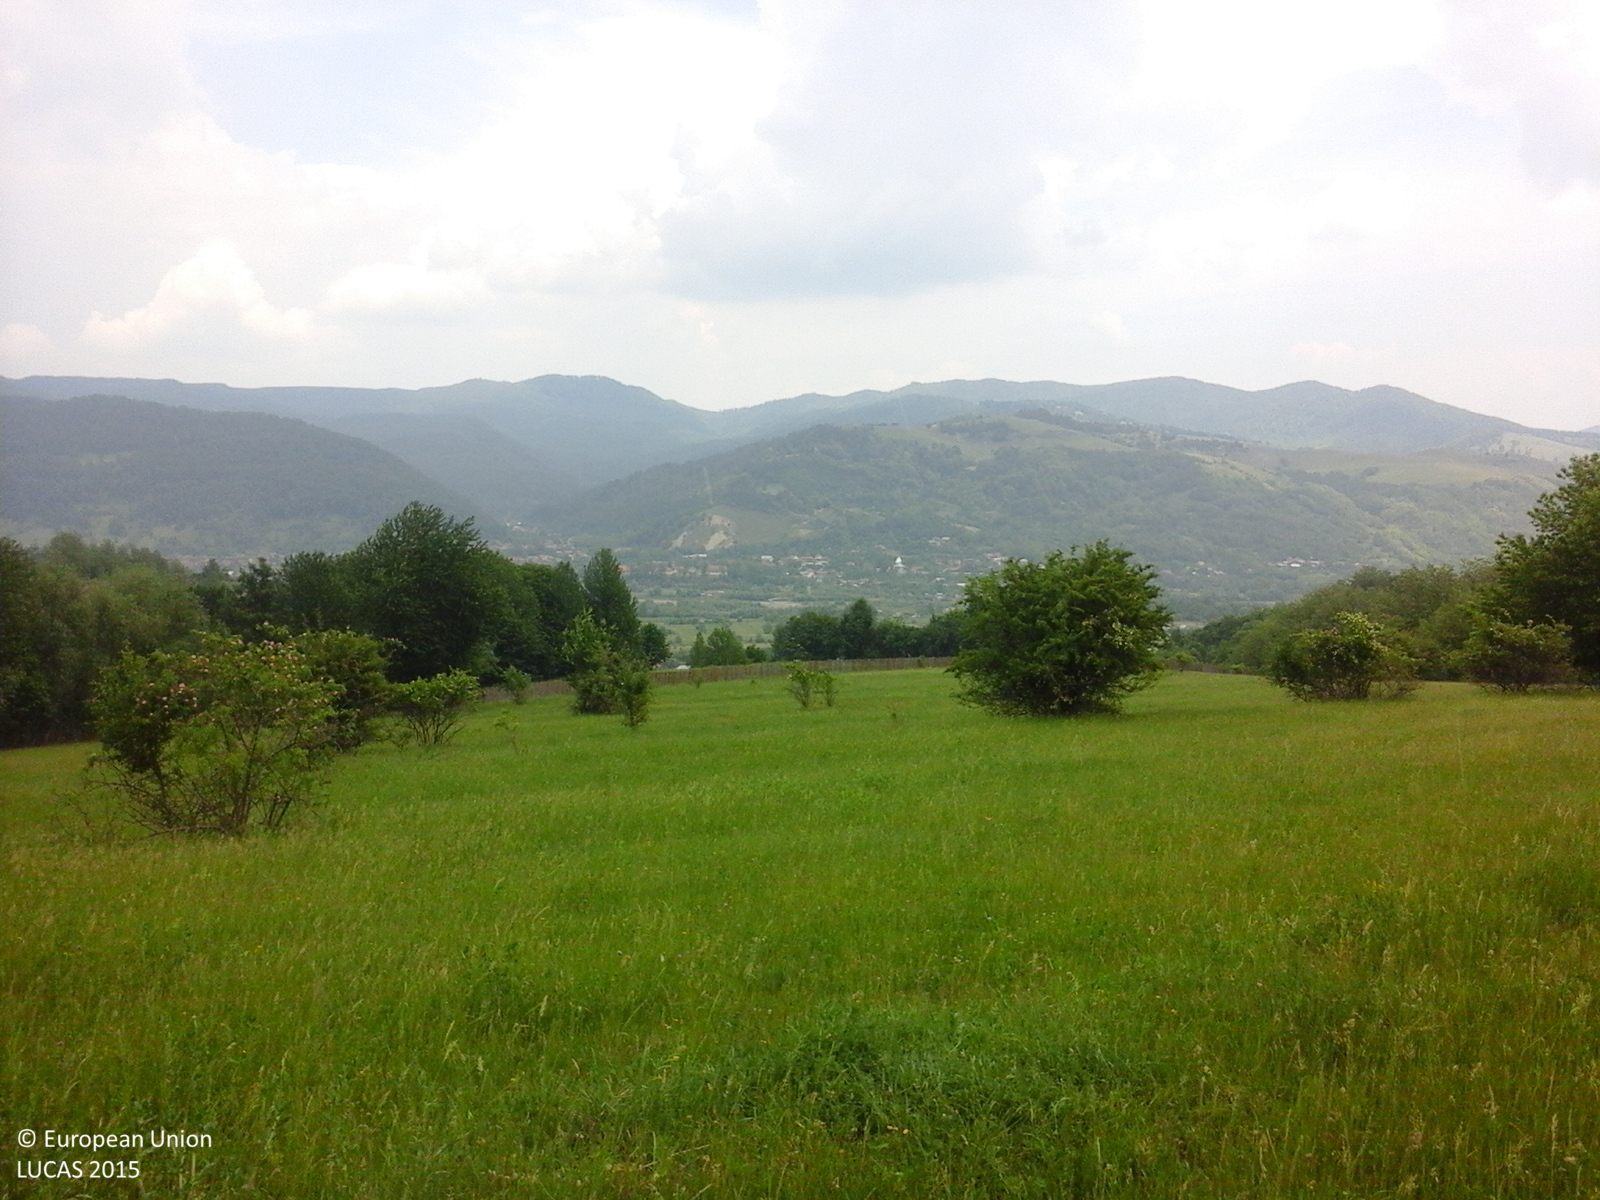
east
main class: Grassland
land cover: Grassland without tree/shrub cover
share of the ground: > 75 %
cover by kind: herbaceous plants 100 %
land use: Agriculture (excluding fallow land and kitchen gardens)
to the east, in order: Grassland without tree/shrub cover; Grassland with sparse tree/shrub cover; Grassland without tree/shrub cover; Fences; Grassland without tree/shrub cover
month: June
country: RO
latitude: 46.3846
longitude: 26.4771
